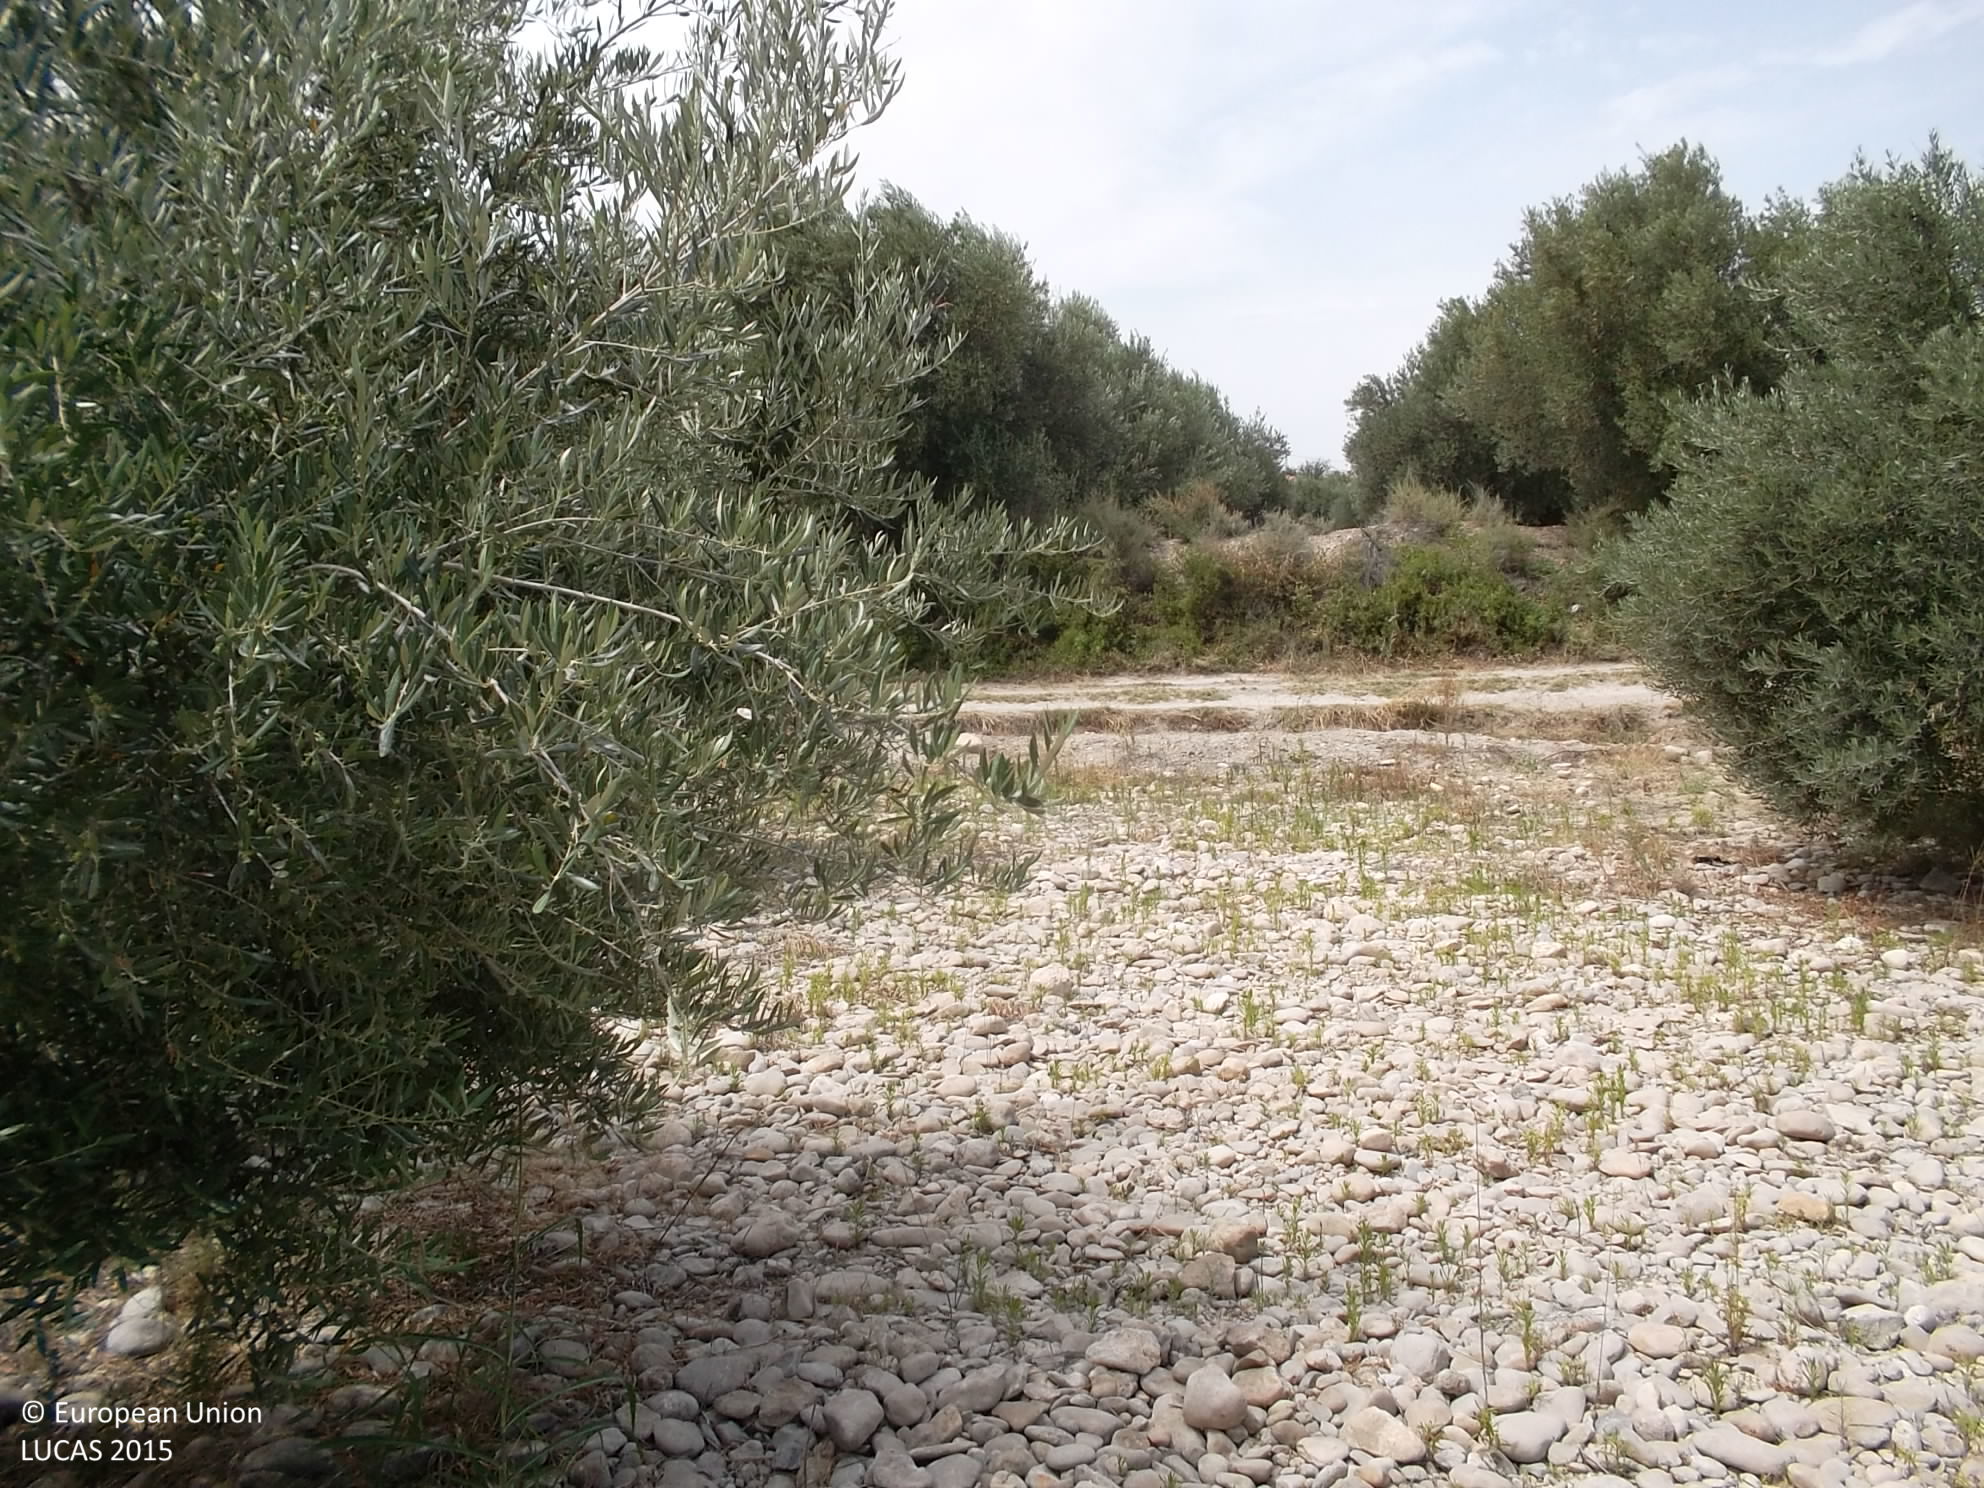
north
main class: Cropland
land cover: Olive groves
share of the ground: 50 - 75 %
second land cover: Other bare soil
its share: > 75 %
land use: Agriculture (excluding fallow land and kitchen gardens)
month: July
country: ES
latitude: 37.6001
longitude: -2.7537
